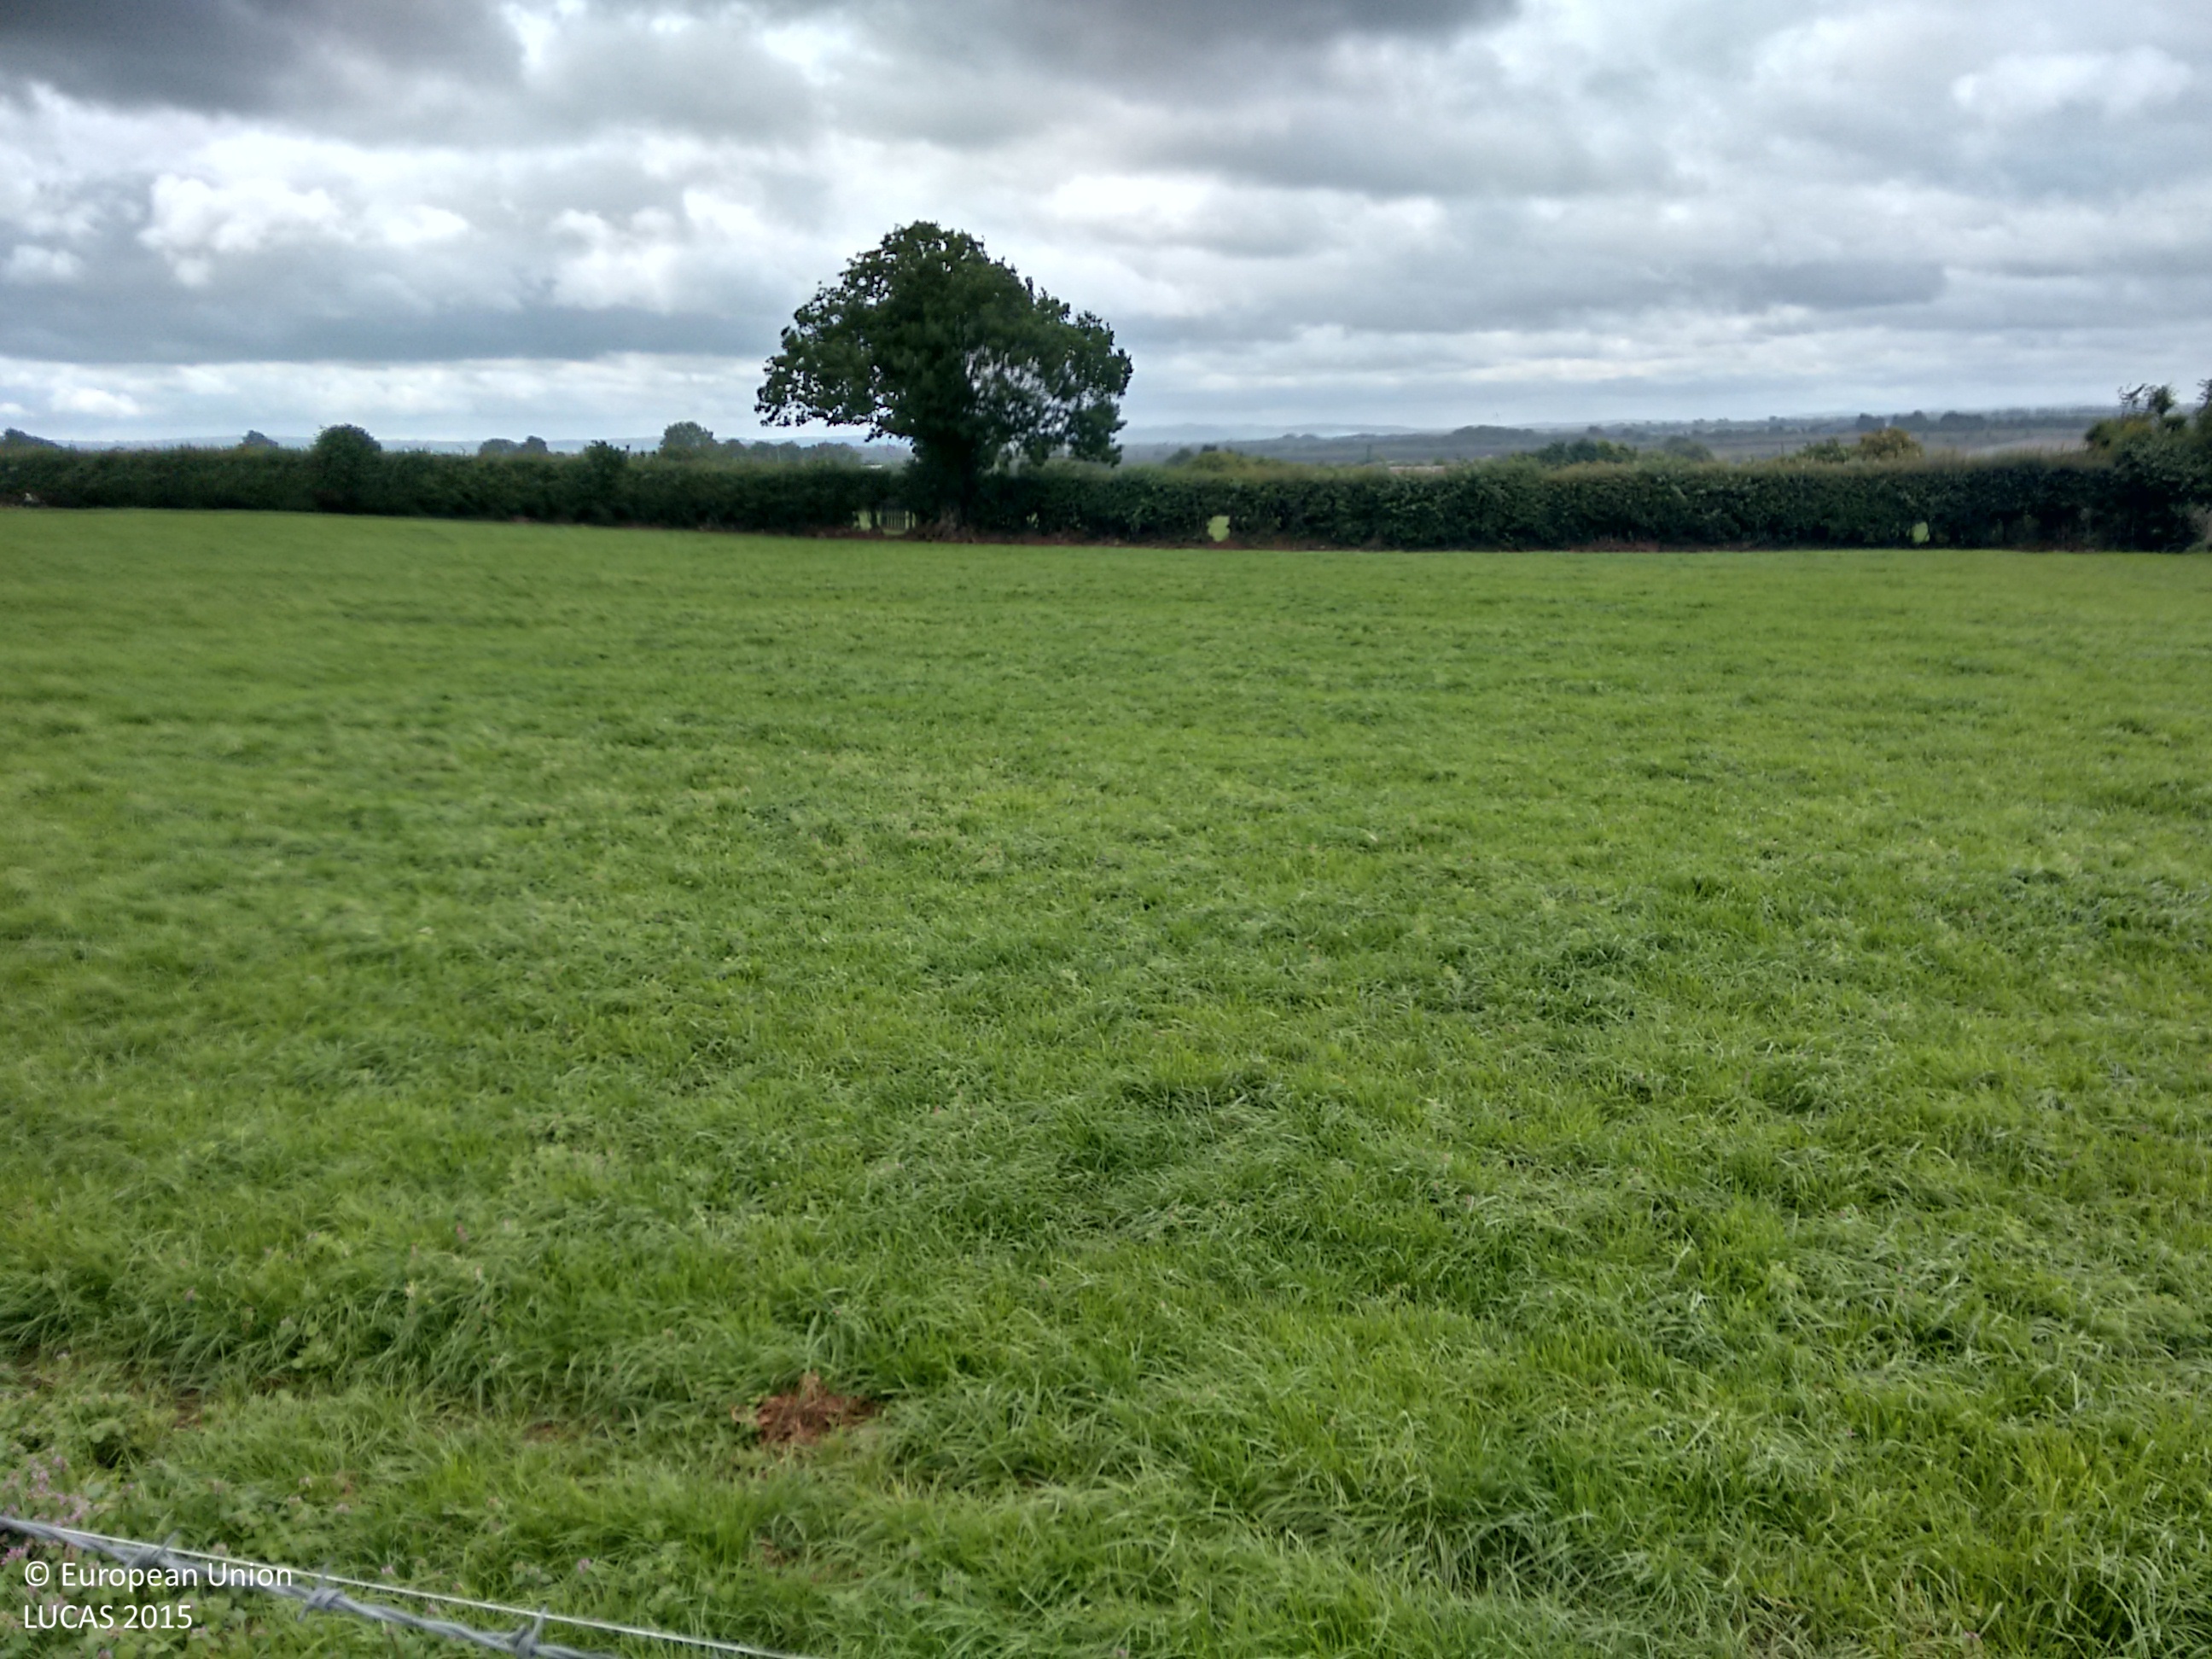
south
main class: Grassland
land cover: Grassland without tree/shrub cover
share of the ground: > 75 %
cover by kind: herbaceous plants 100 %
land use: Agriculture (excluding fallow land and kitchen gardens)
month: July
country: IE
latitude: 52.7562
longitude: -7.6327
